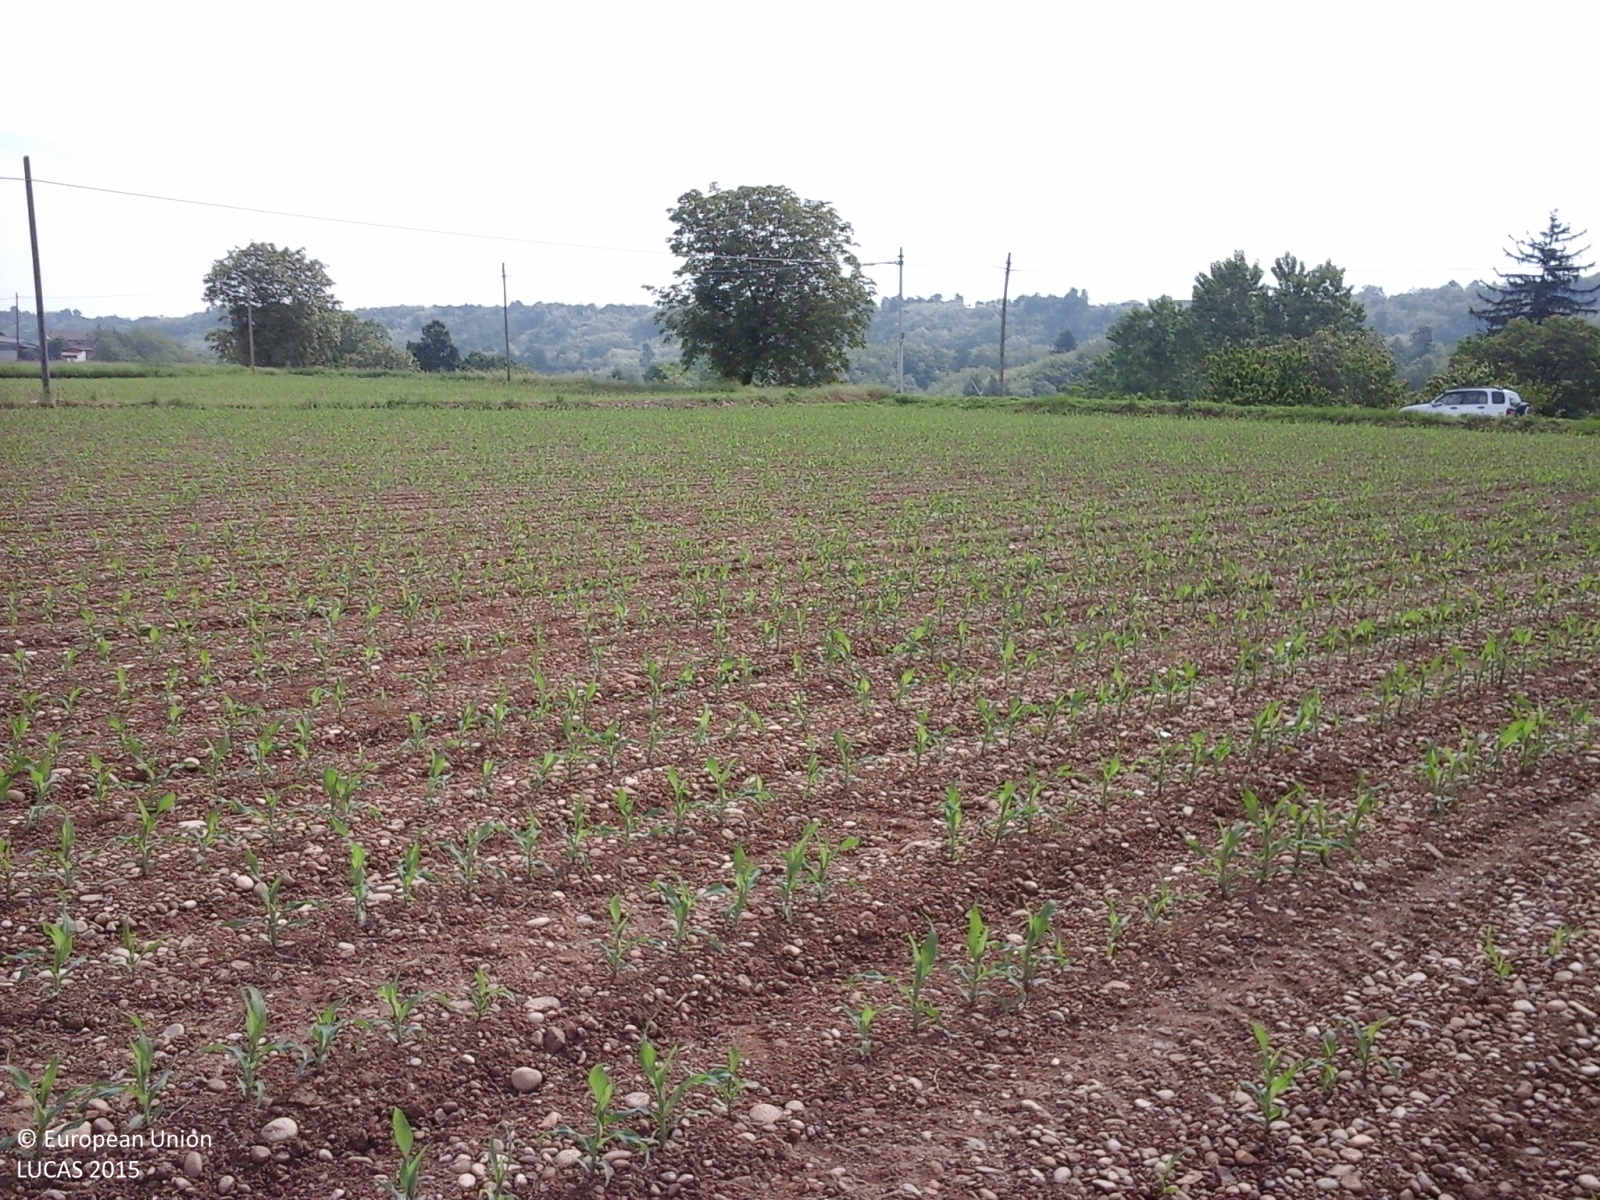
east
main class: Cropland
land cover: Maize
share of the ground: 25 - 50 %
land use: Agriculture (excluding fallow land and kitchen gardens)
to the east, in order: Maize; Grass margins; Electric lines; Paved roads, cycling and walking lanes; Grass margins; Ditches and canals; Abandoned hedges; Grassland without tree/shrub cover; Broadleaved woodland; Grassland without tree/shrub cover
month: May
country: IT
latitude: 44.5427
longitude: 7.7517
